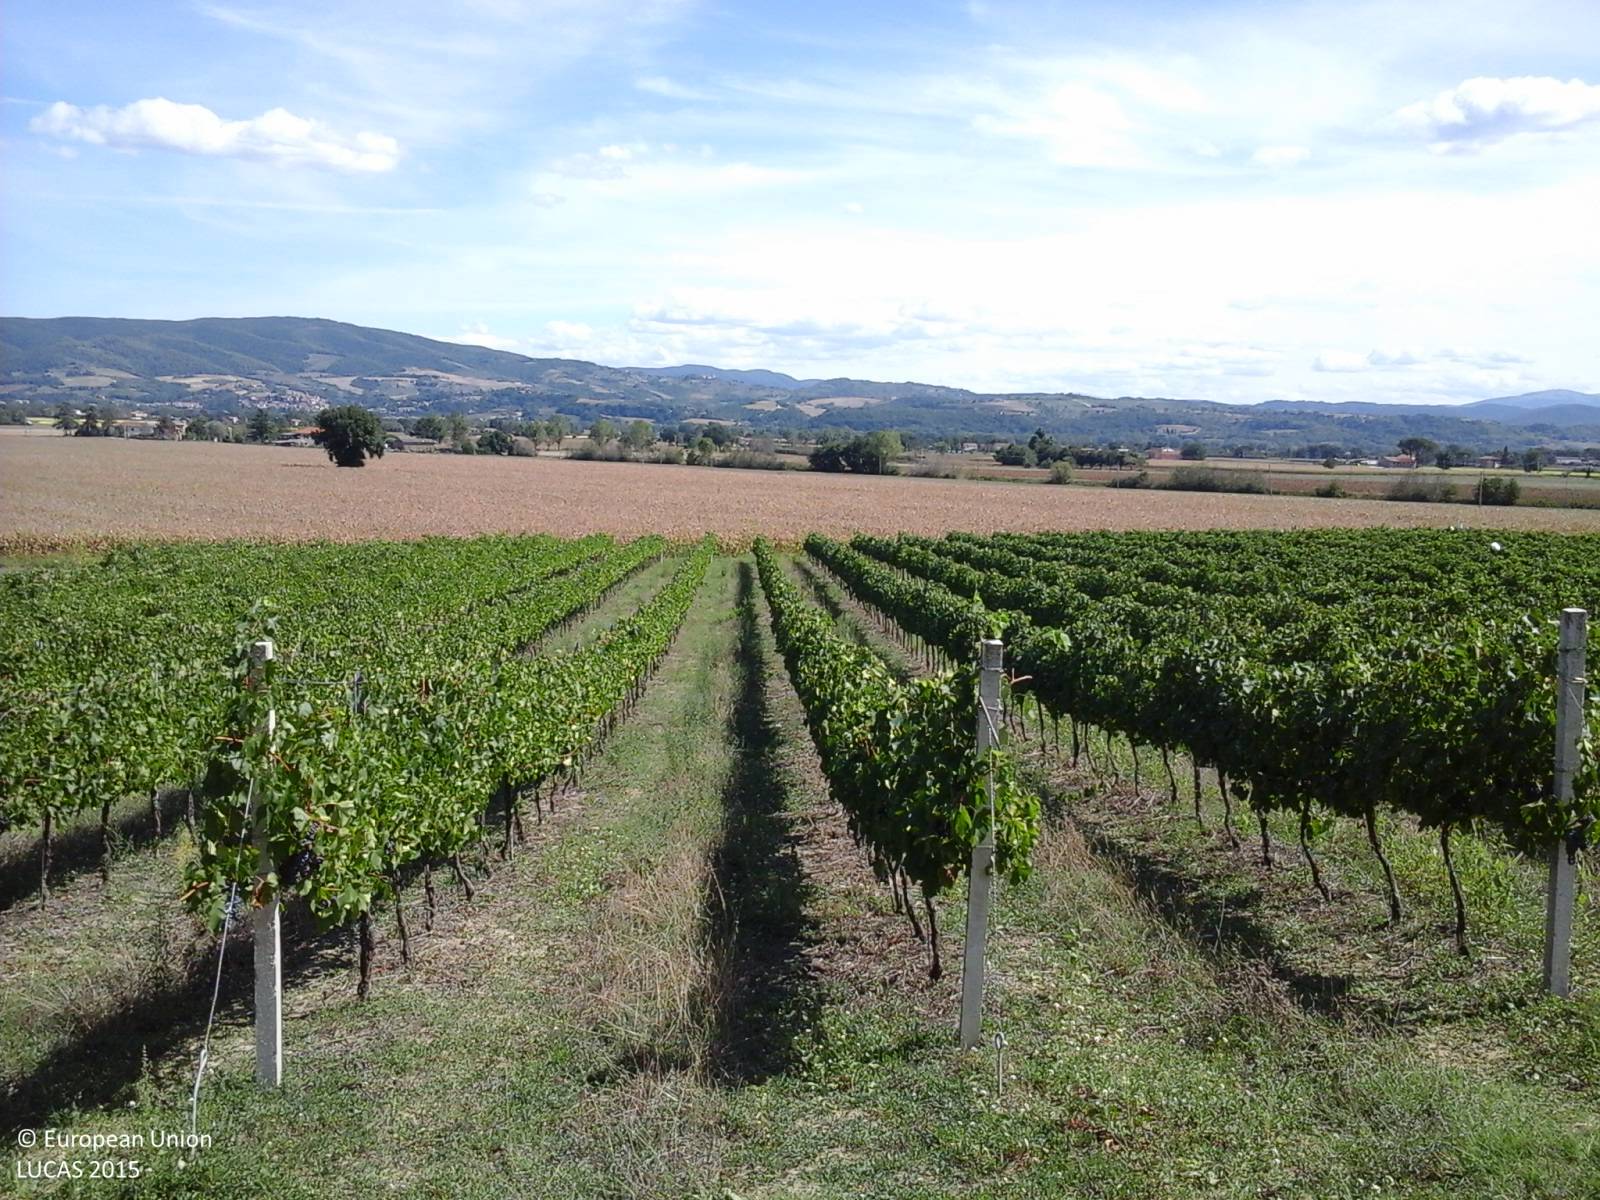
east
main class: Grassland
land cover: Grassland without tree/shrub cover
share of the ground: 25 - 50 %
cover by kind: herbaceous plants 100 %
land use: Agriculture (excluding fallow land and kitchen gardens)
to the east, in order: Grassland without tree/shrub cover; Vineyards; Grassland without tree/shrub cover; Ditches and canals; Grass margins; Tracks; Shruby margins; Ditches and canals; Shruby margins; Maize
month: September
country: IT
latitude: 42.9878
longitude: 12.3600
